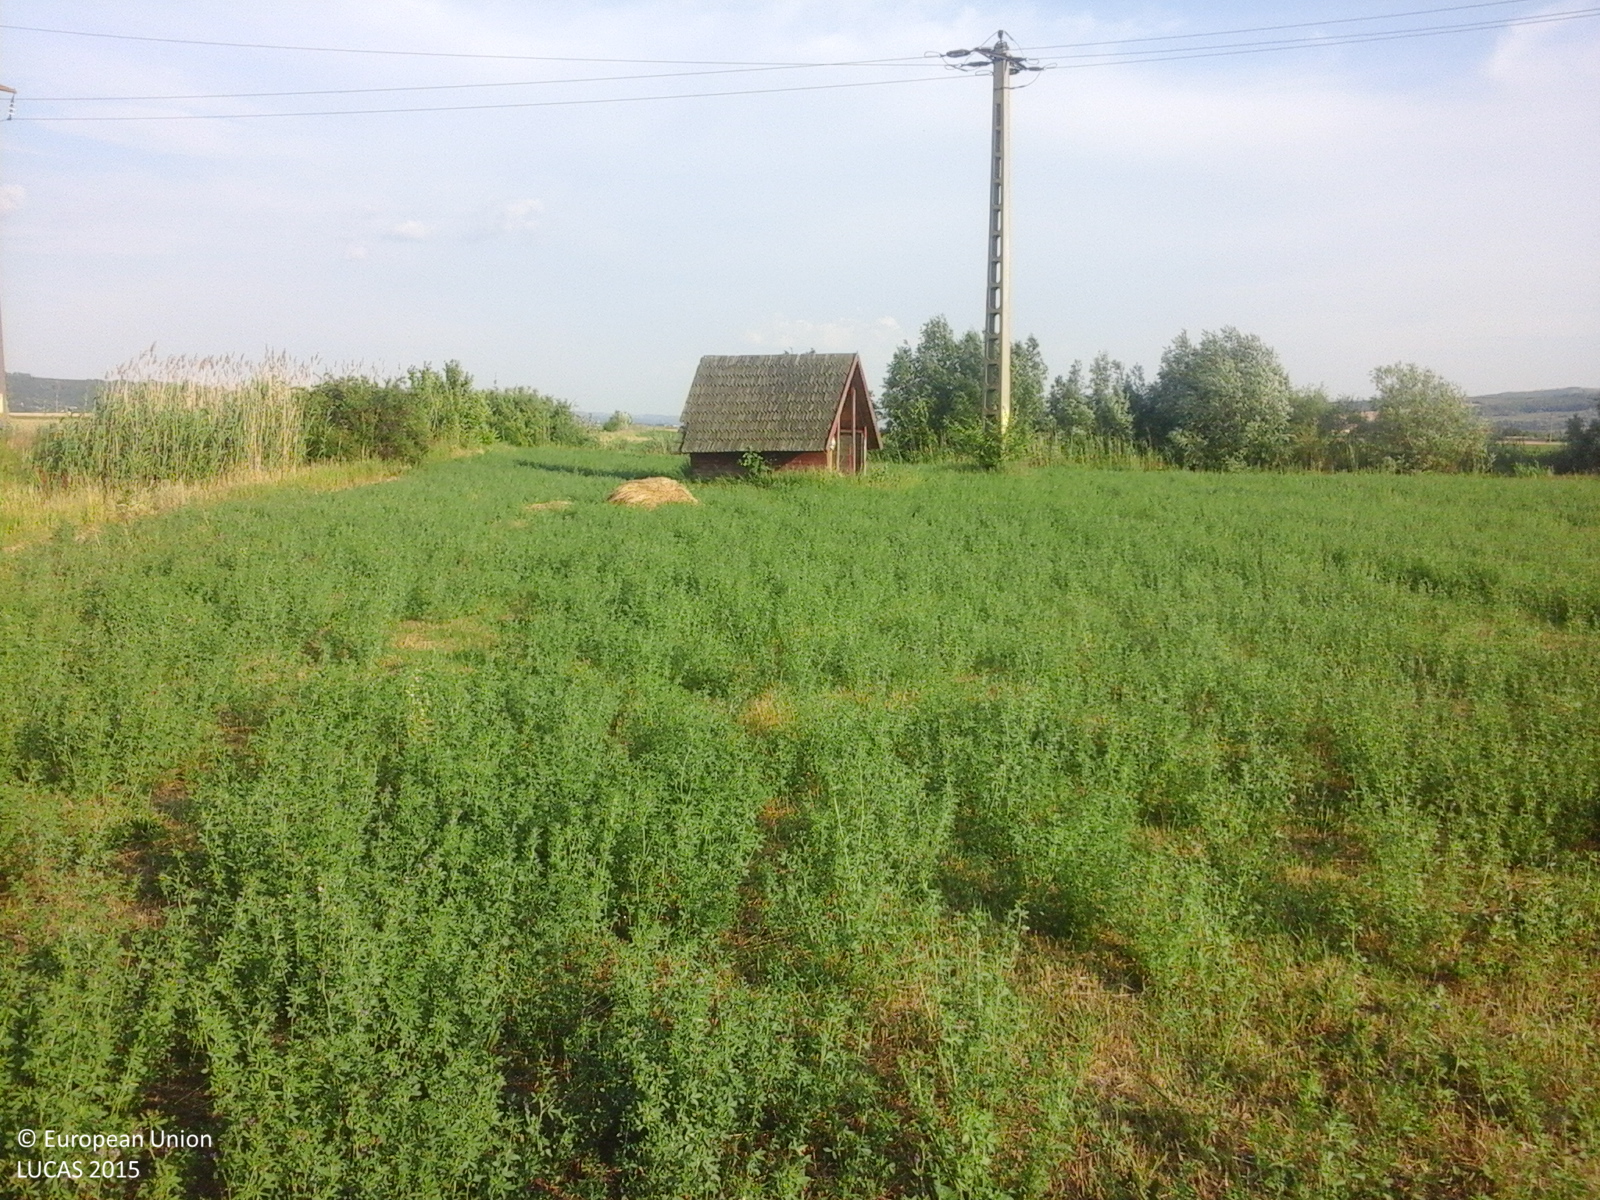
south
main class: Cropland
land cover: Lucerne
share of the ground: > 75 %
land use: Agriculture (excluding fallow land and kitchen gardens)
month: June
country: RO
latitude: 46.6223
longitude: 27.7363
